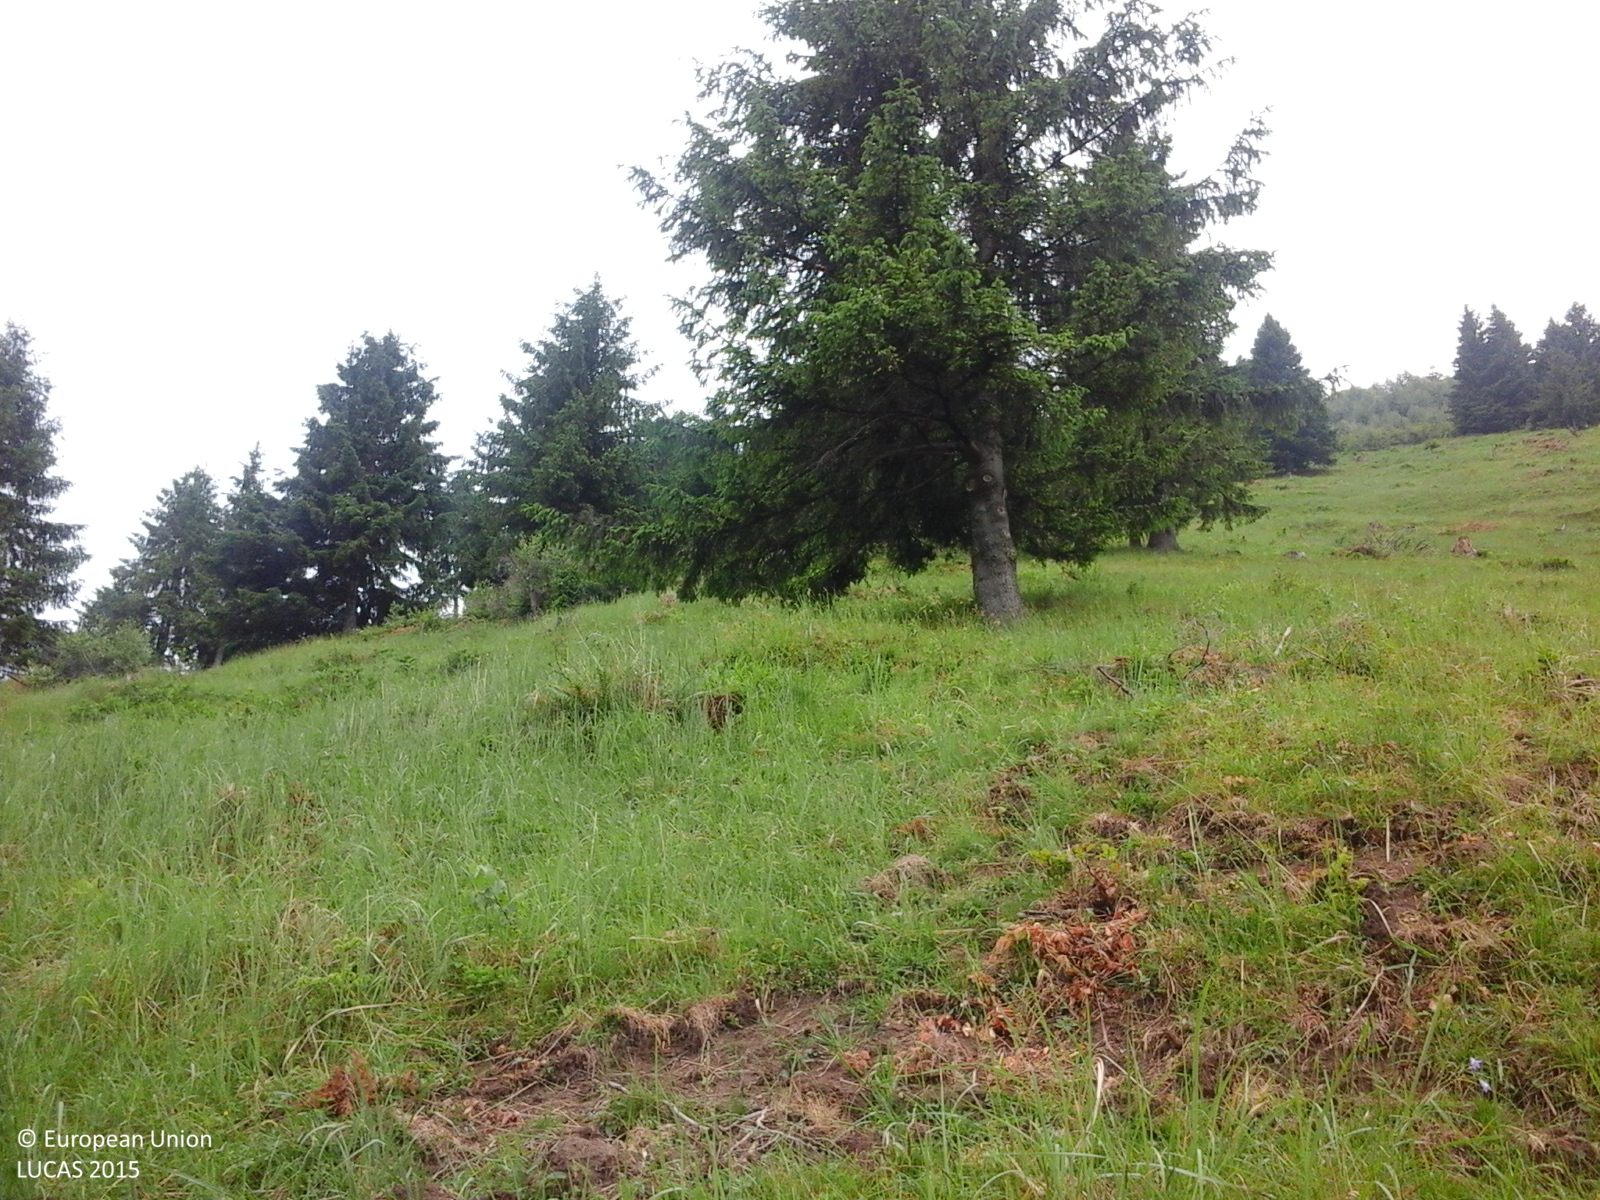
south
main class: Grassland
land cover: Grassland with sparse tree/shrub cover
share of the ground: > 75 %
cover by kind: herbaceous plants 95 %, coniferous forest trees 5 %
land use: Agriculture (excluding fallow land and kitchen gardens)
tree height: > 5 m
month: June
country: RO
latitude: 46.4179
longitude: 26.3806
